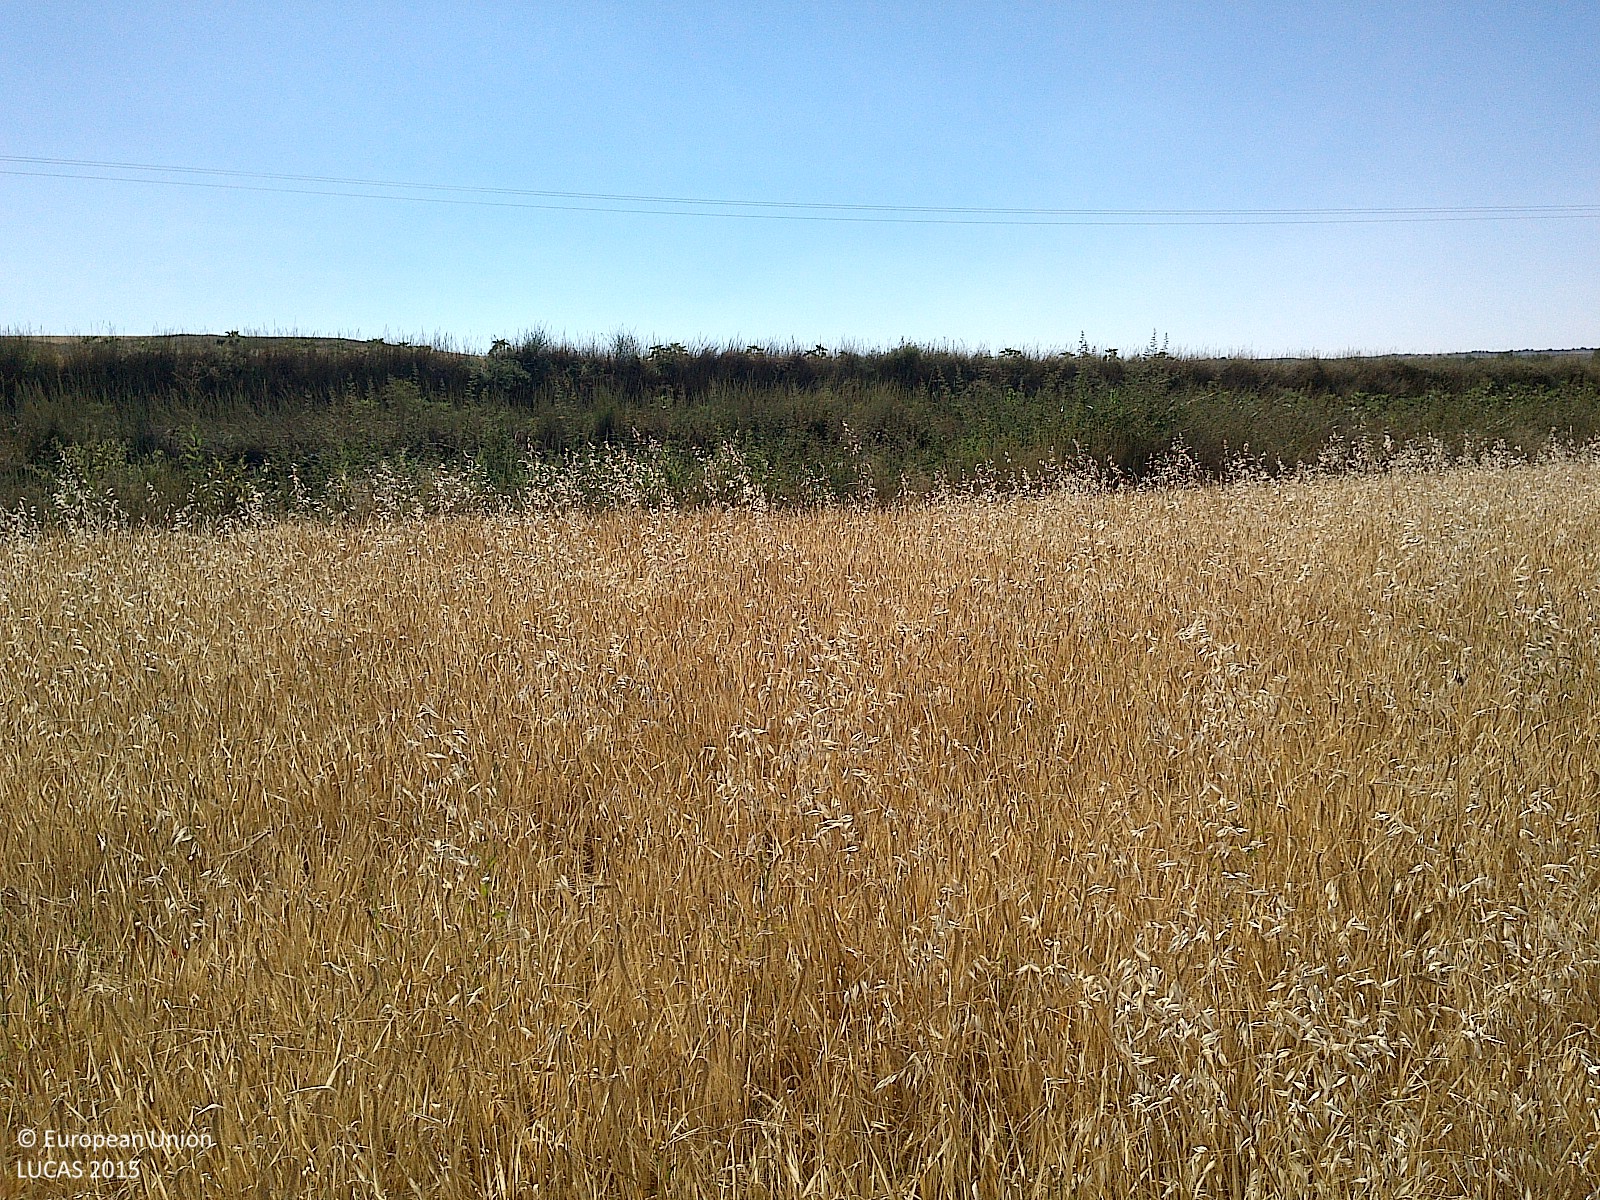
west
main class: Cropland
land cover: Barley
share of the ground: > 75 %
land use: Agriculture (excluding fallow land and kitchen gardens)
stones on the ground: < 10 %
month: July
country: ES
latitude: 41.6377
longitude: -3.2152
